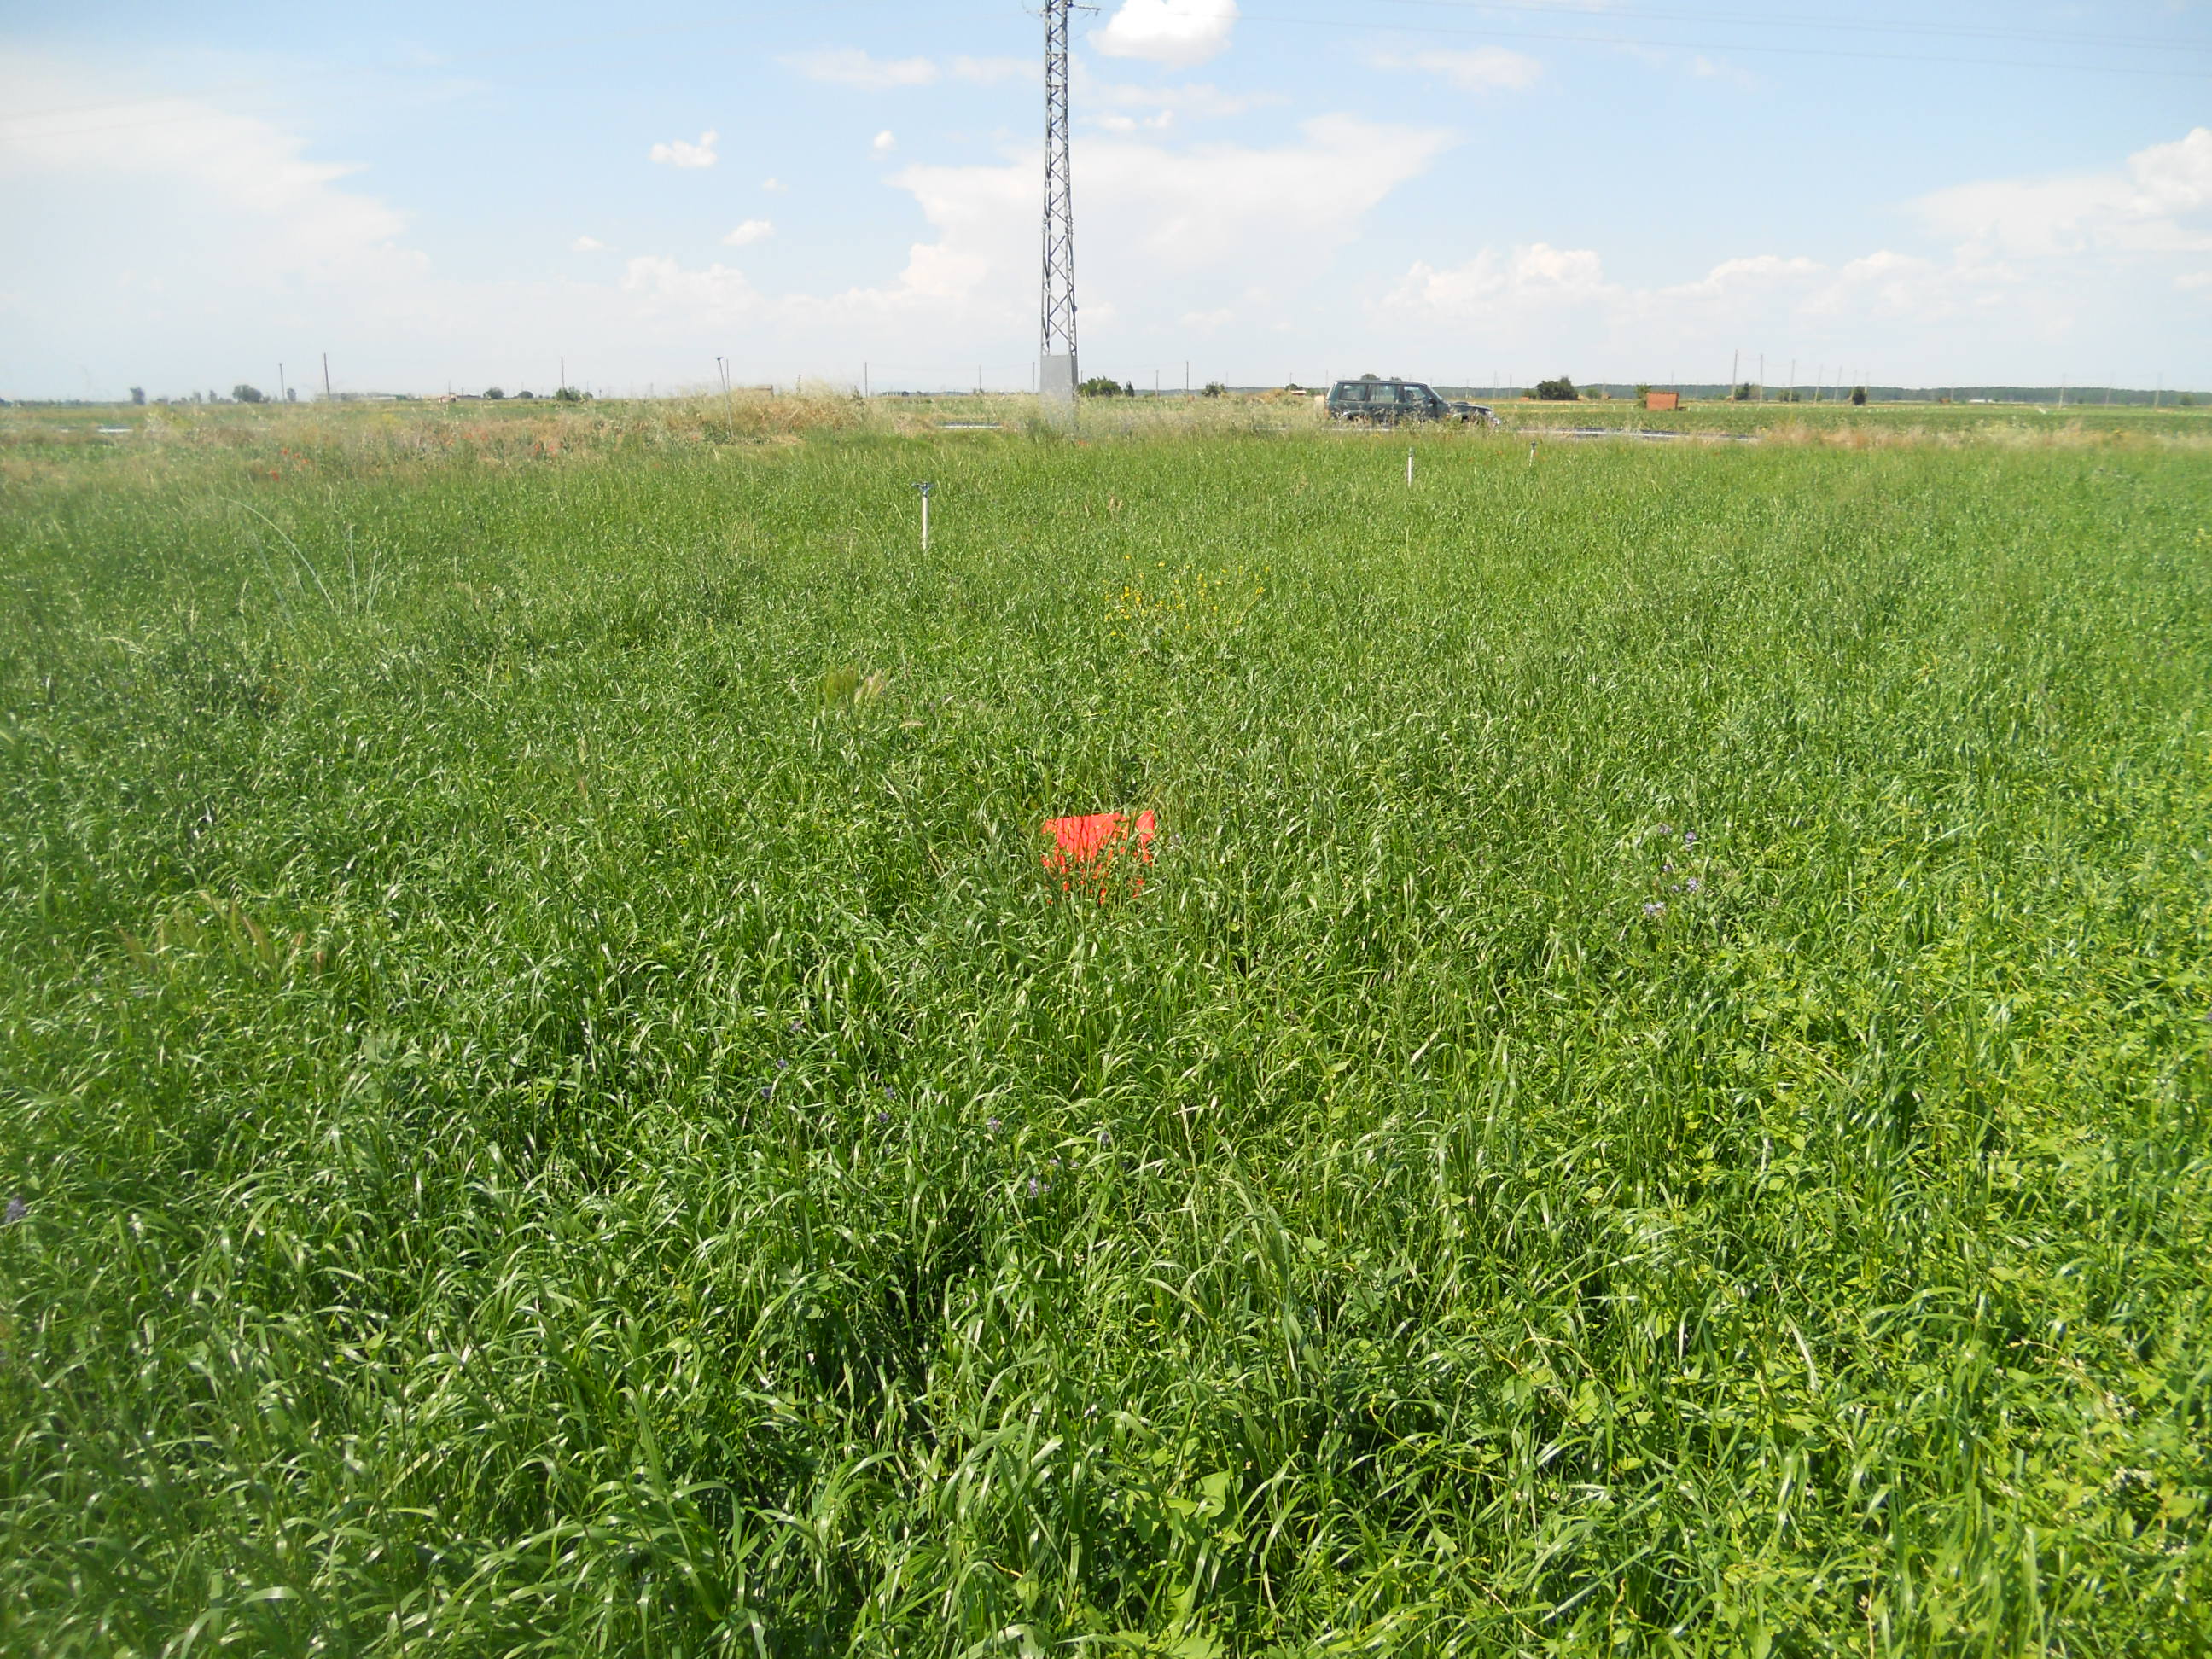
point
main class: Cropland
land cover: Temporary grasslands
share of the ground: > 75 %
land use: Agriculture (excluding fallow land and kitchen gardens)
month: June
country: ES
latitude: 42.2379
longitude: -5.6415
